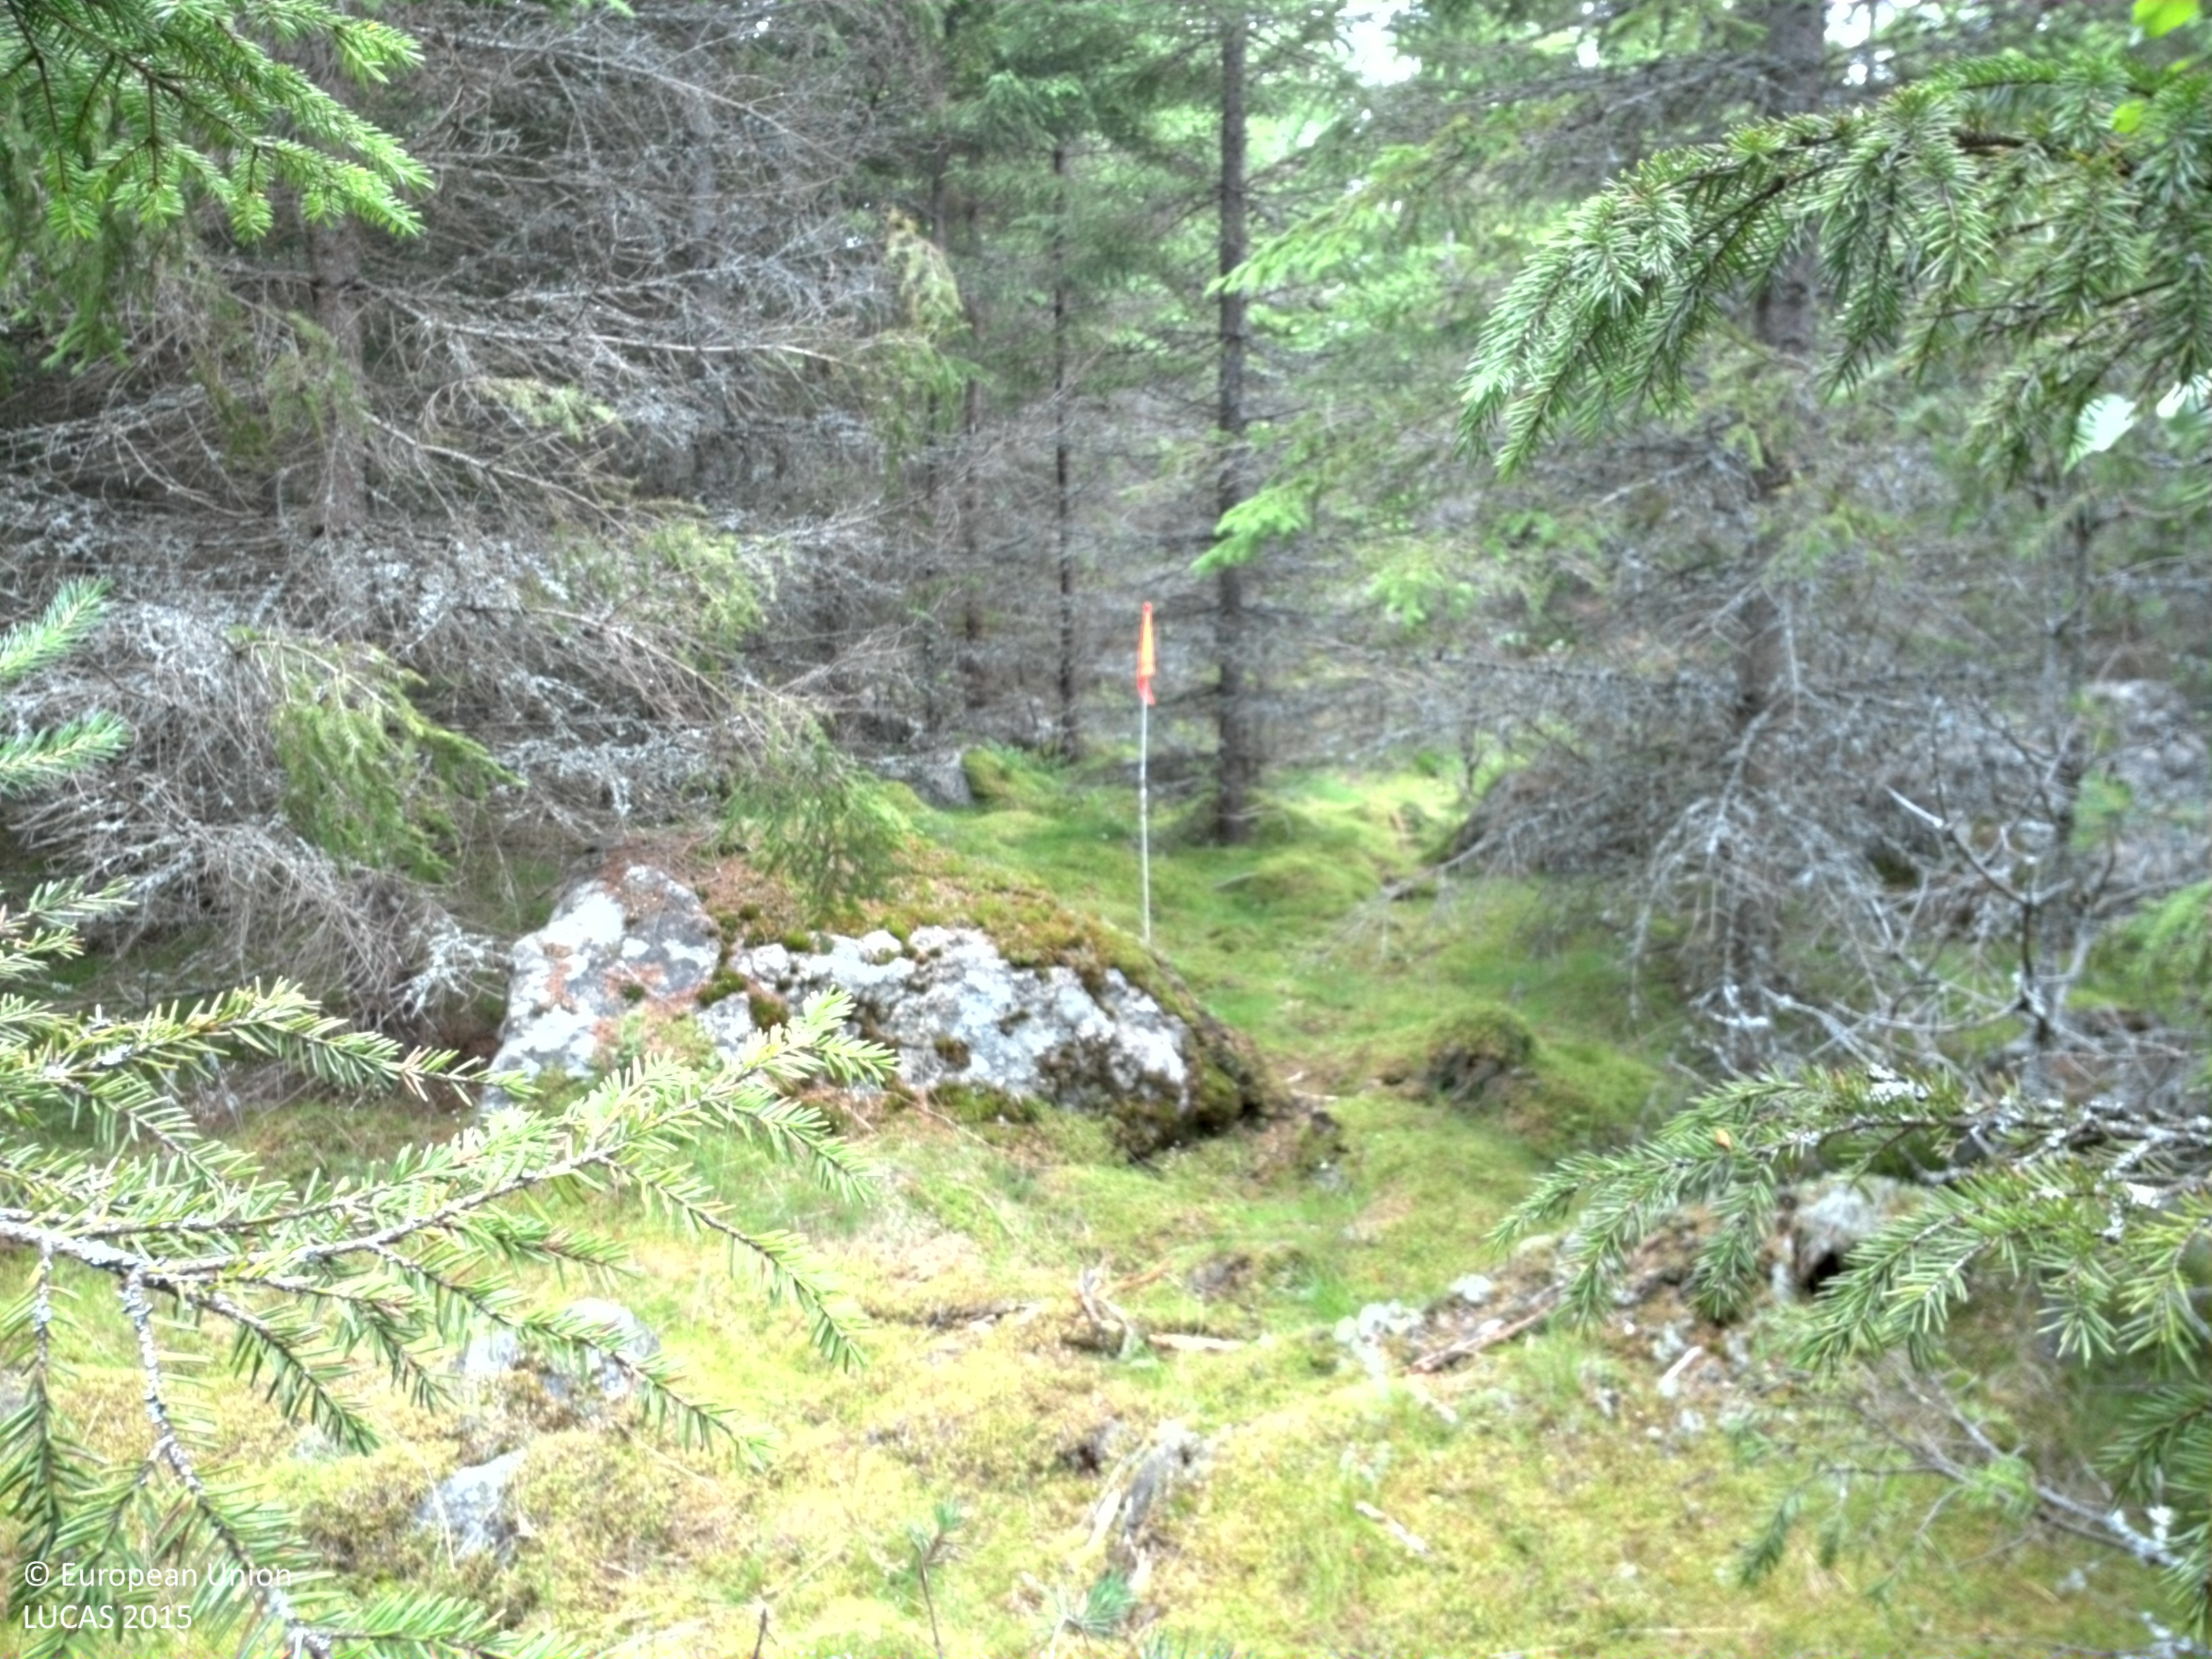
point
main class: Woodland
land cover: Spruce dominated coniferous woodland
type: boreal forest
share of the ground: 25 - 50 %
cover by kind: coniferous forest trees 45 %, lichens and mosses 45 %, herbaceous plants 10 %
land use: Forestry
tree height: < 5 m
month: July
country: SE
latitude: 58.7628
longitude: 15.3354
